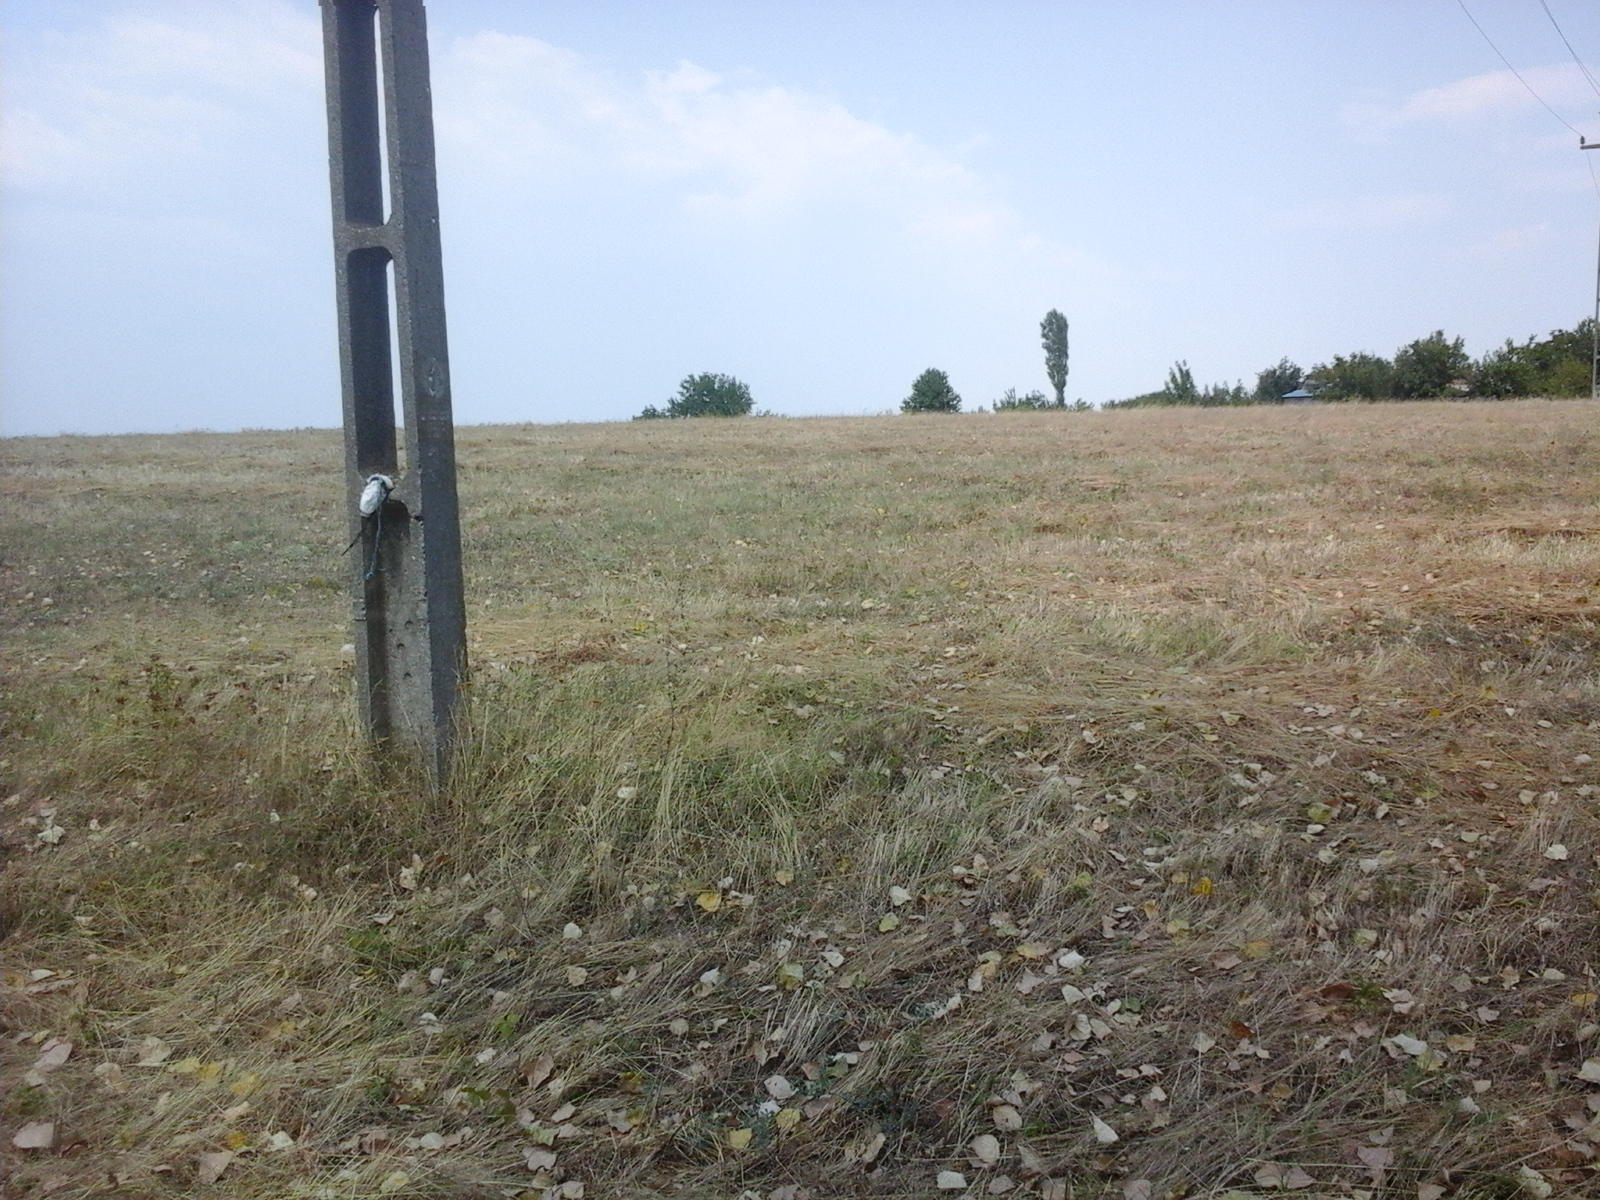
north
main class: Grassland
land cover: Grassland without tree/shrub cover
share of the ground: > 75 %
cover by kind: herbaceous plants 100 %
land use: Agriculture (excluding fallow land and kitchen gardens)
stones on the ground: < 10 %
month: August
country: RO
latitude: 44.5200
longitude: 22.6597
